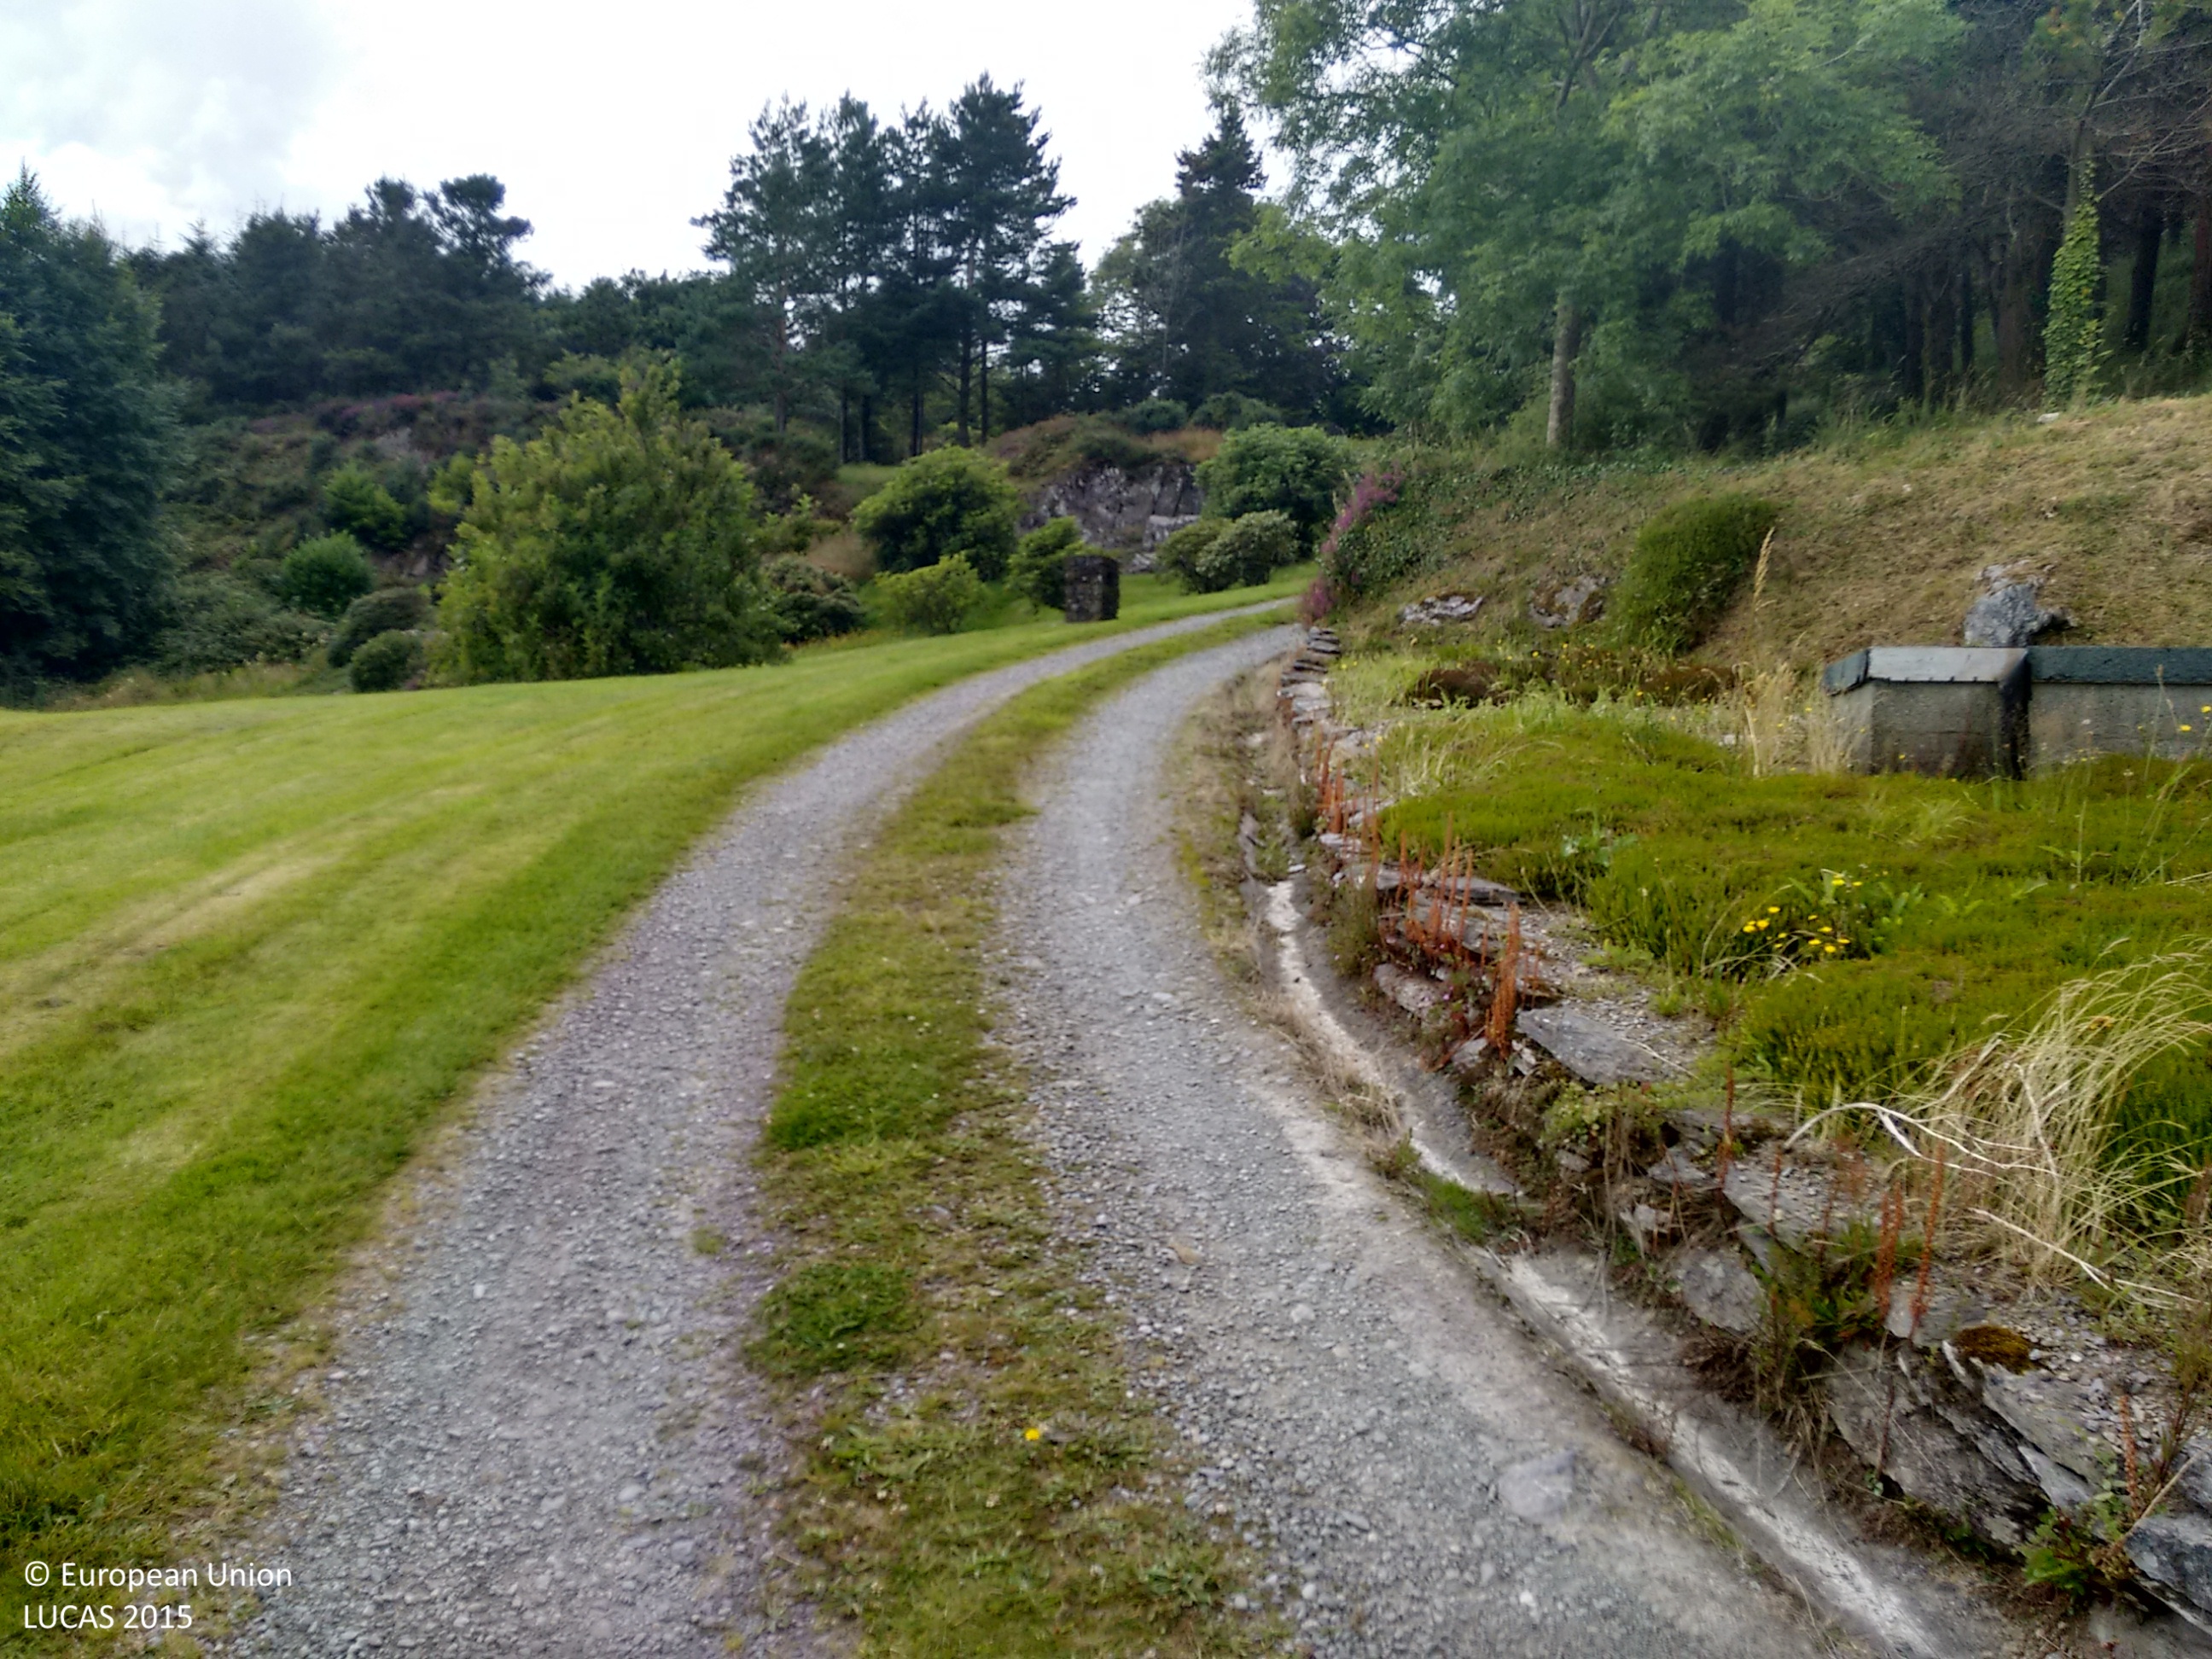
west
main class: Grassland
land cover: Grassland without tree/shrub cover
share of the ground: > 75 %
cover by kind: herbaceous plants 80 %
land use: Residential
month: July
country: IE
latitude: 51.5510
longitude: -9.3947
